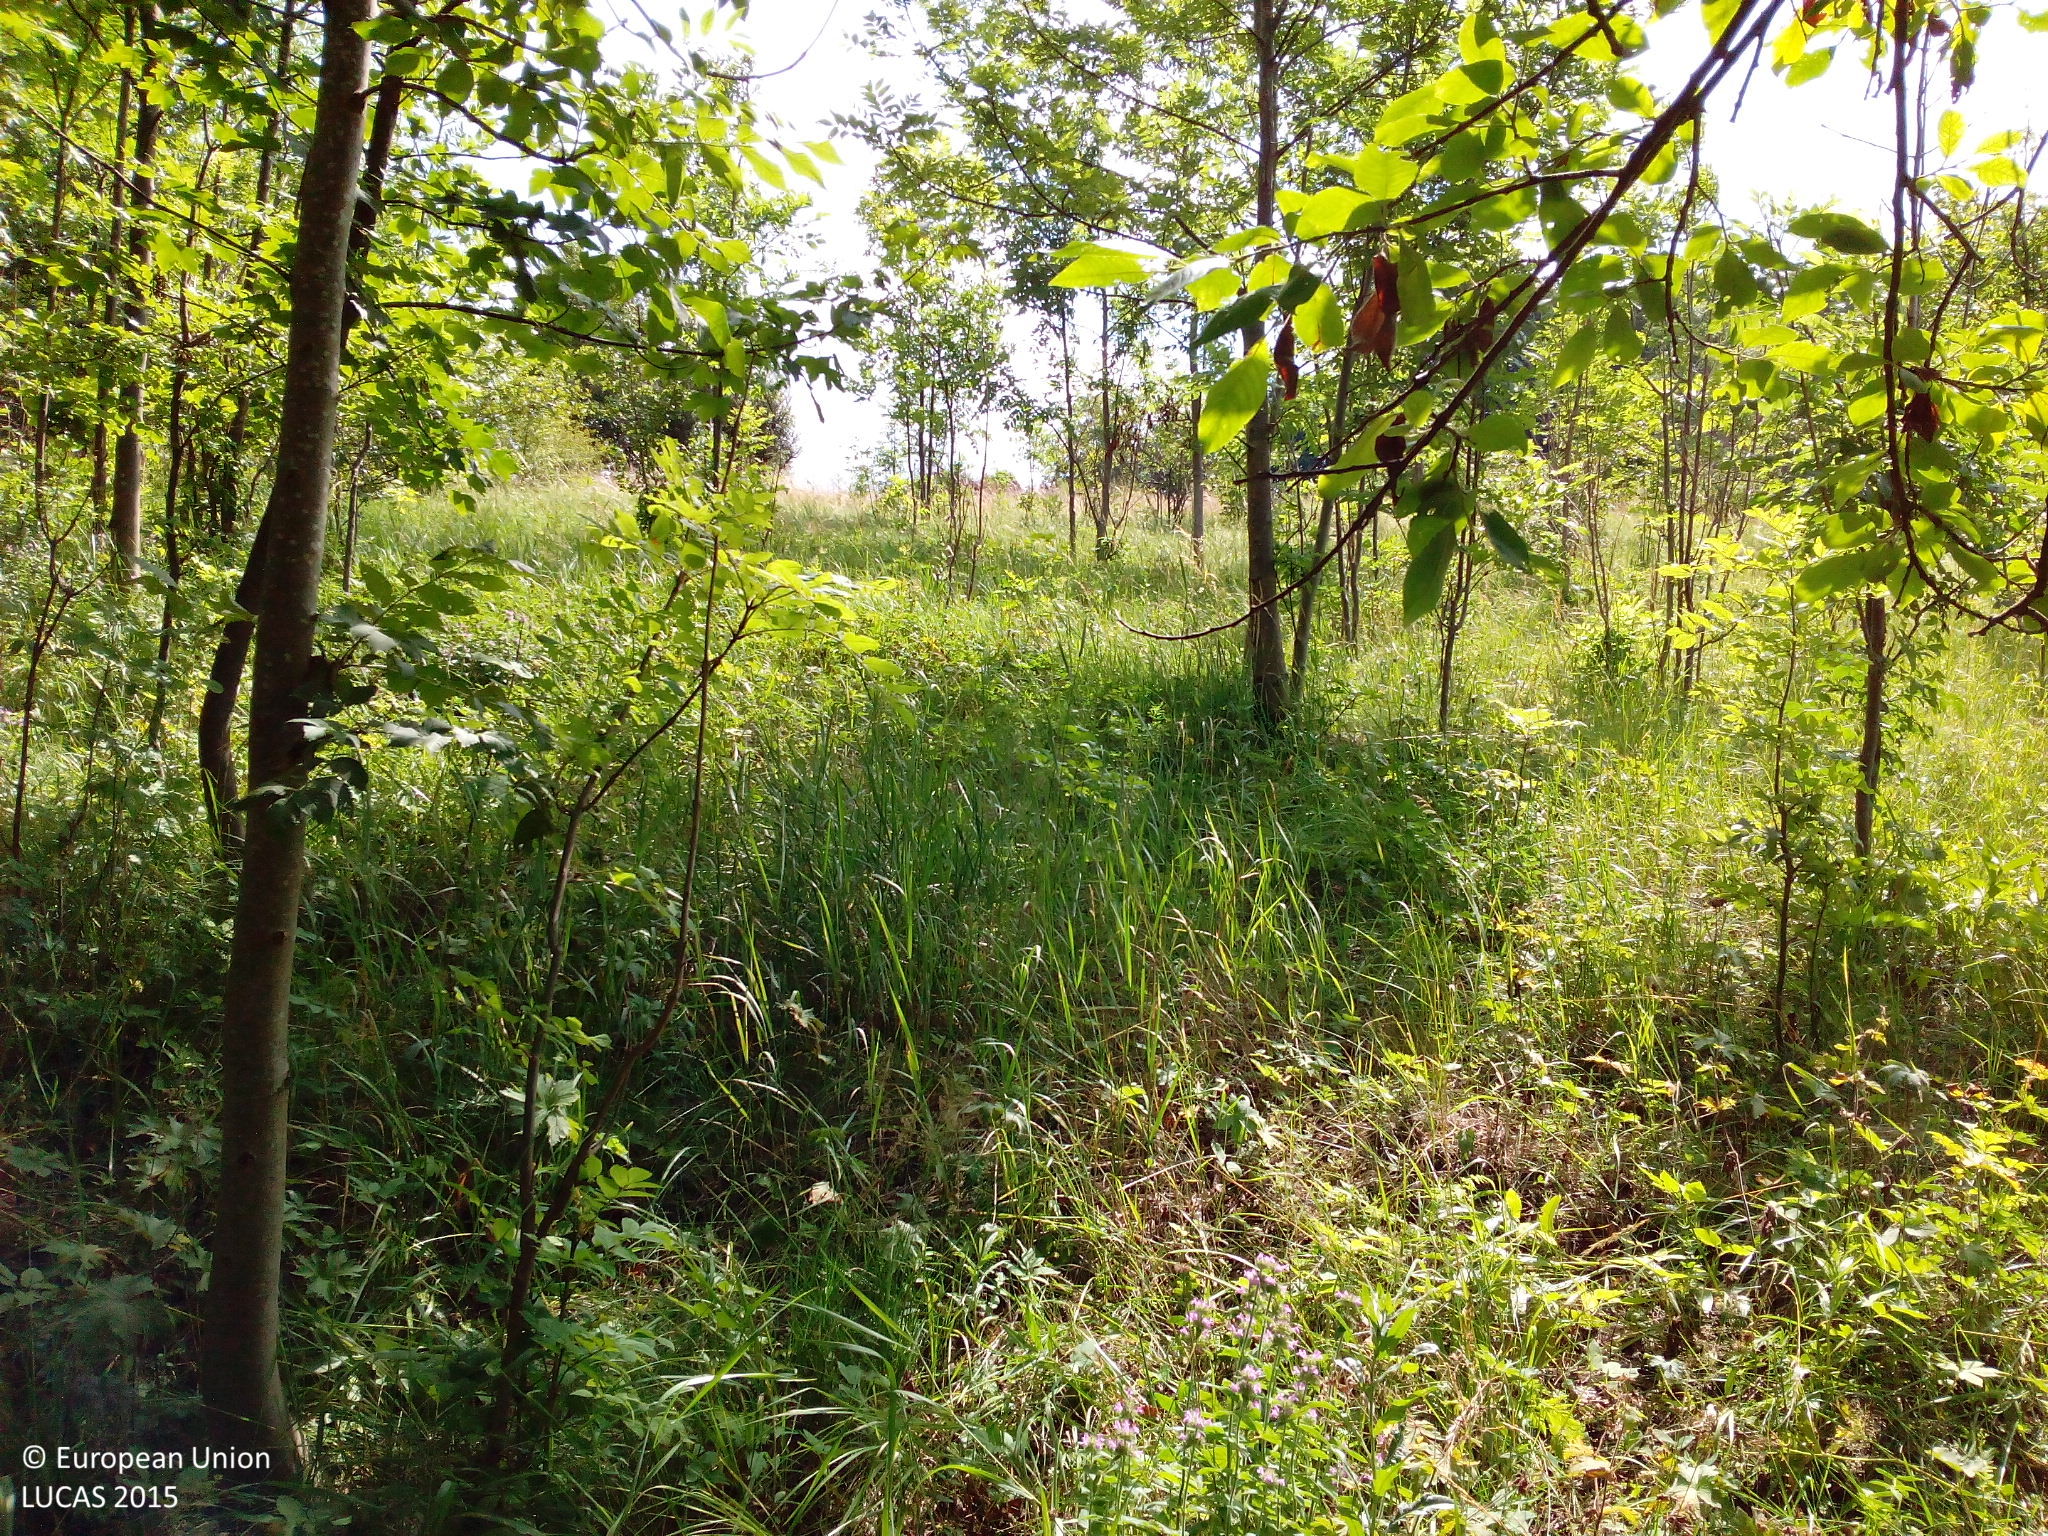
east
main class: Woodland
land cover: Broadleaved woodland
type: mesophytic deciduous forest
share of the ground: > 75 %
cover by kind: broadleaved forest trees 90 %, herbaceous plants 10 %
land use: Forestry
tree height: > 5 m
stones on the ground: < 10 %
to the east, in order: Broadleaved woodland; Grass margins; Paved roads, cycling and walking lanes; Grassland without tree/shrub cover; Shrubland with sparse tree cover; Grassland without tree/shrub cover; Broadleaved woodland; Grass margins; Tracks; Grassland with sparse tree/shrub cover; Fences; Spontaneously vegetated surfaces; Broadleaved woodland; Grassland without tree/shrub cover
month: July
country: DE
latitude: 50.5079
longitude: 9.9295
